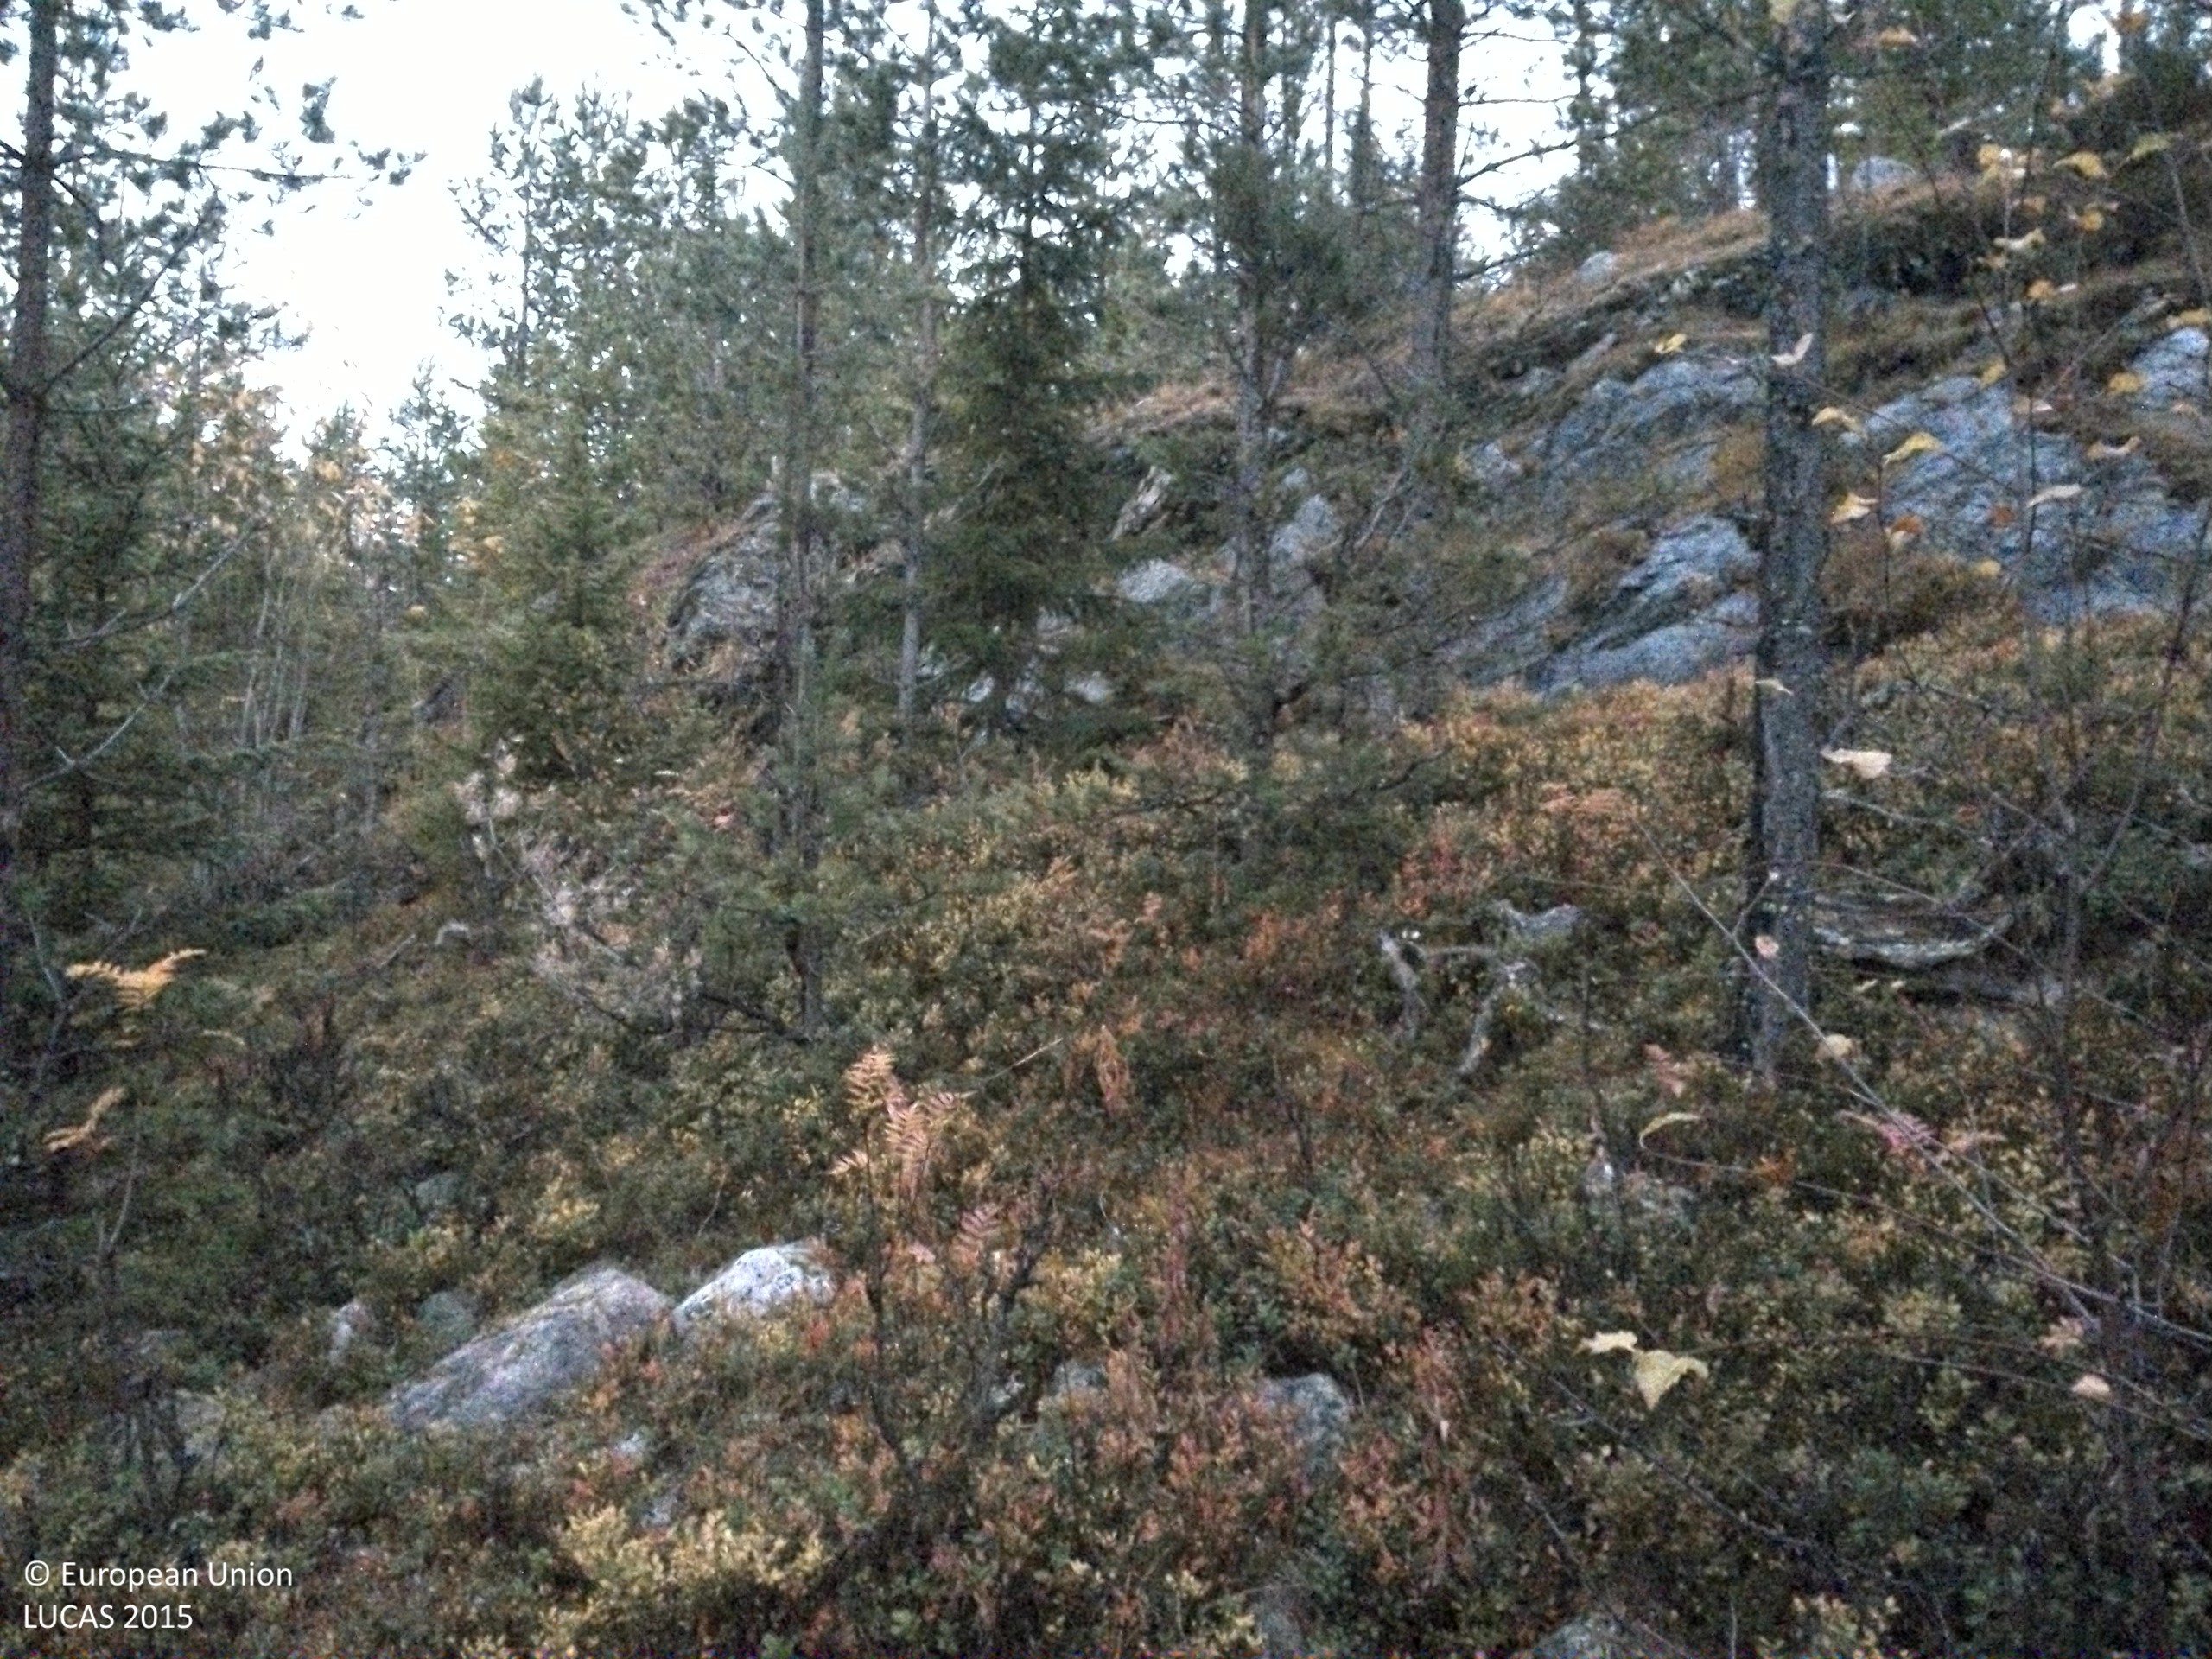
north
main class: Woodland
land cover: Pine dominated coniferous woodland
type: boreal forest
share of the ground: 25 - 50 %
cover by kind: coniferous forest trees 35 %, shrubs 25 %, consolidated bare surface 20 %, lichens and mosses 15 %, broadleaved forest trees 5 %
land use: Forestry
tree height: > 5 m
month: October
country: SE
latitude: 64.3308
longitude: 15.2066
